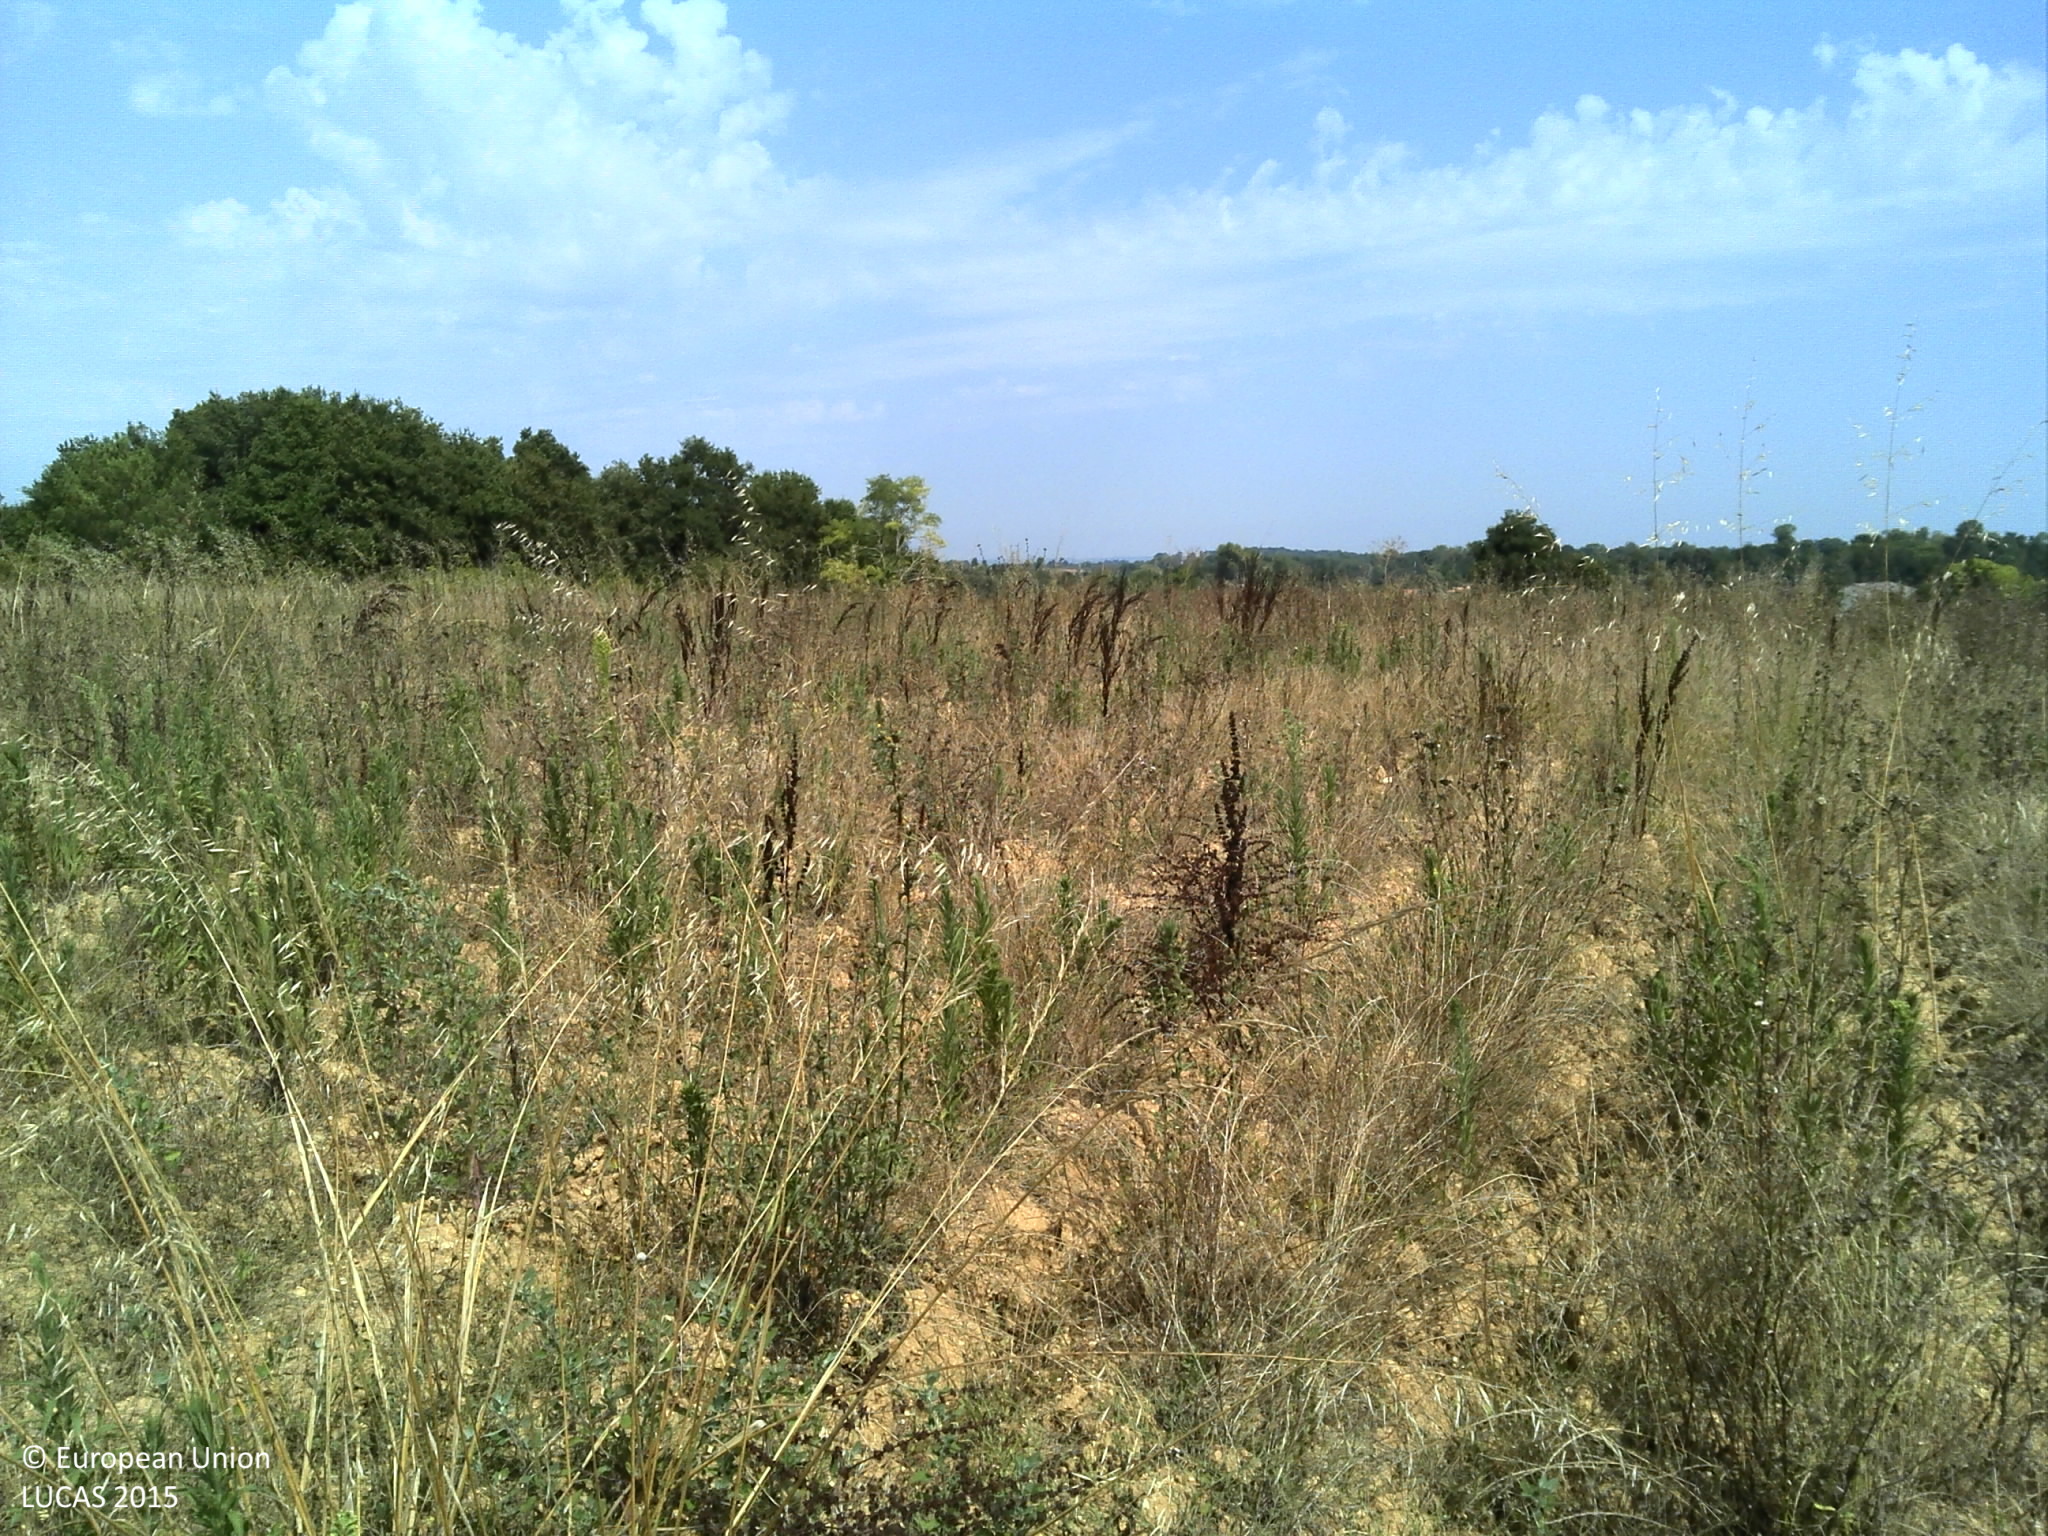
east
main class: Grassland
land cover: Spontaneously vegetated surfaces
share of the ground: 50 - 75 %
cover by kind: herbaceous plants 50 %, unconsolidated bare surface 50 %
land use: Semi-natural and natural areas not in use
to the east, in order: Spontaneously vegetated surfaces; Tracks; Spontaneously vegetated surfaces; Tracks; Grass margins; Tracks; Vineyards; Tracks; Vineyards
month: August
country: FR
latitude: 45.2863
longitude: -0.8739
